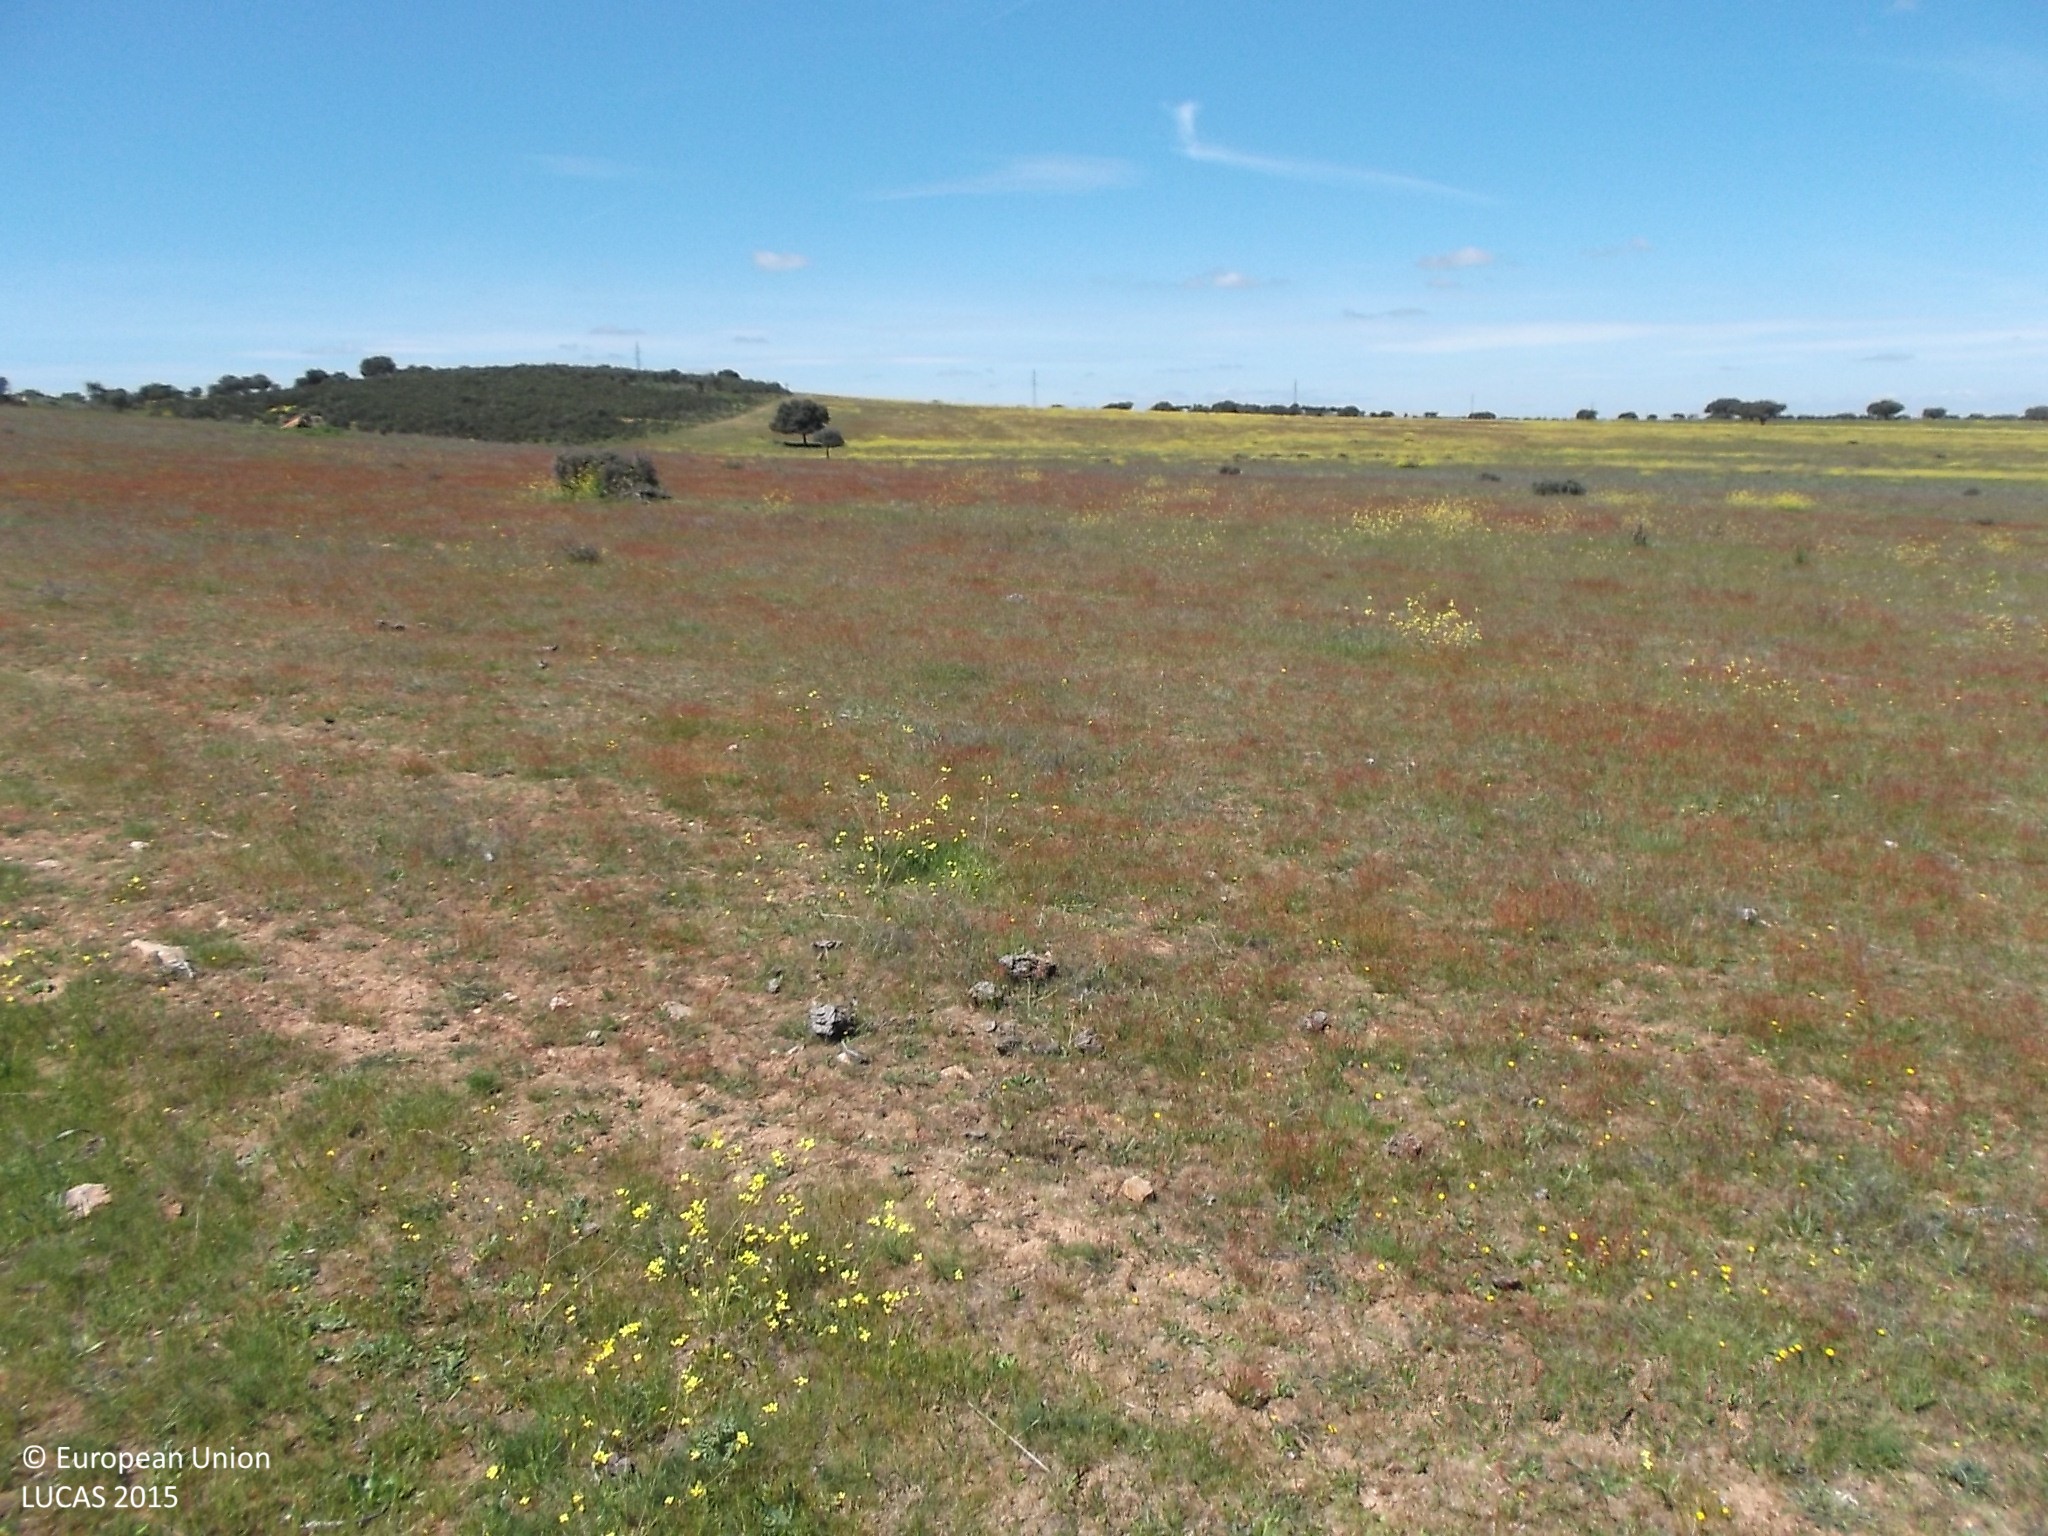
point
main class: Grassland
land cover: Grassland without tree/shrub cover
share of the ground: > 75 %
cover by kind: herbaceous plants 100 %
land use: Agriculture (excluding fallow land and kitchen gardens)
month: April
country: ES
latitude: 41.0370
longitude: -5.9157
